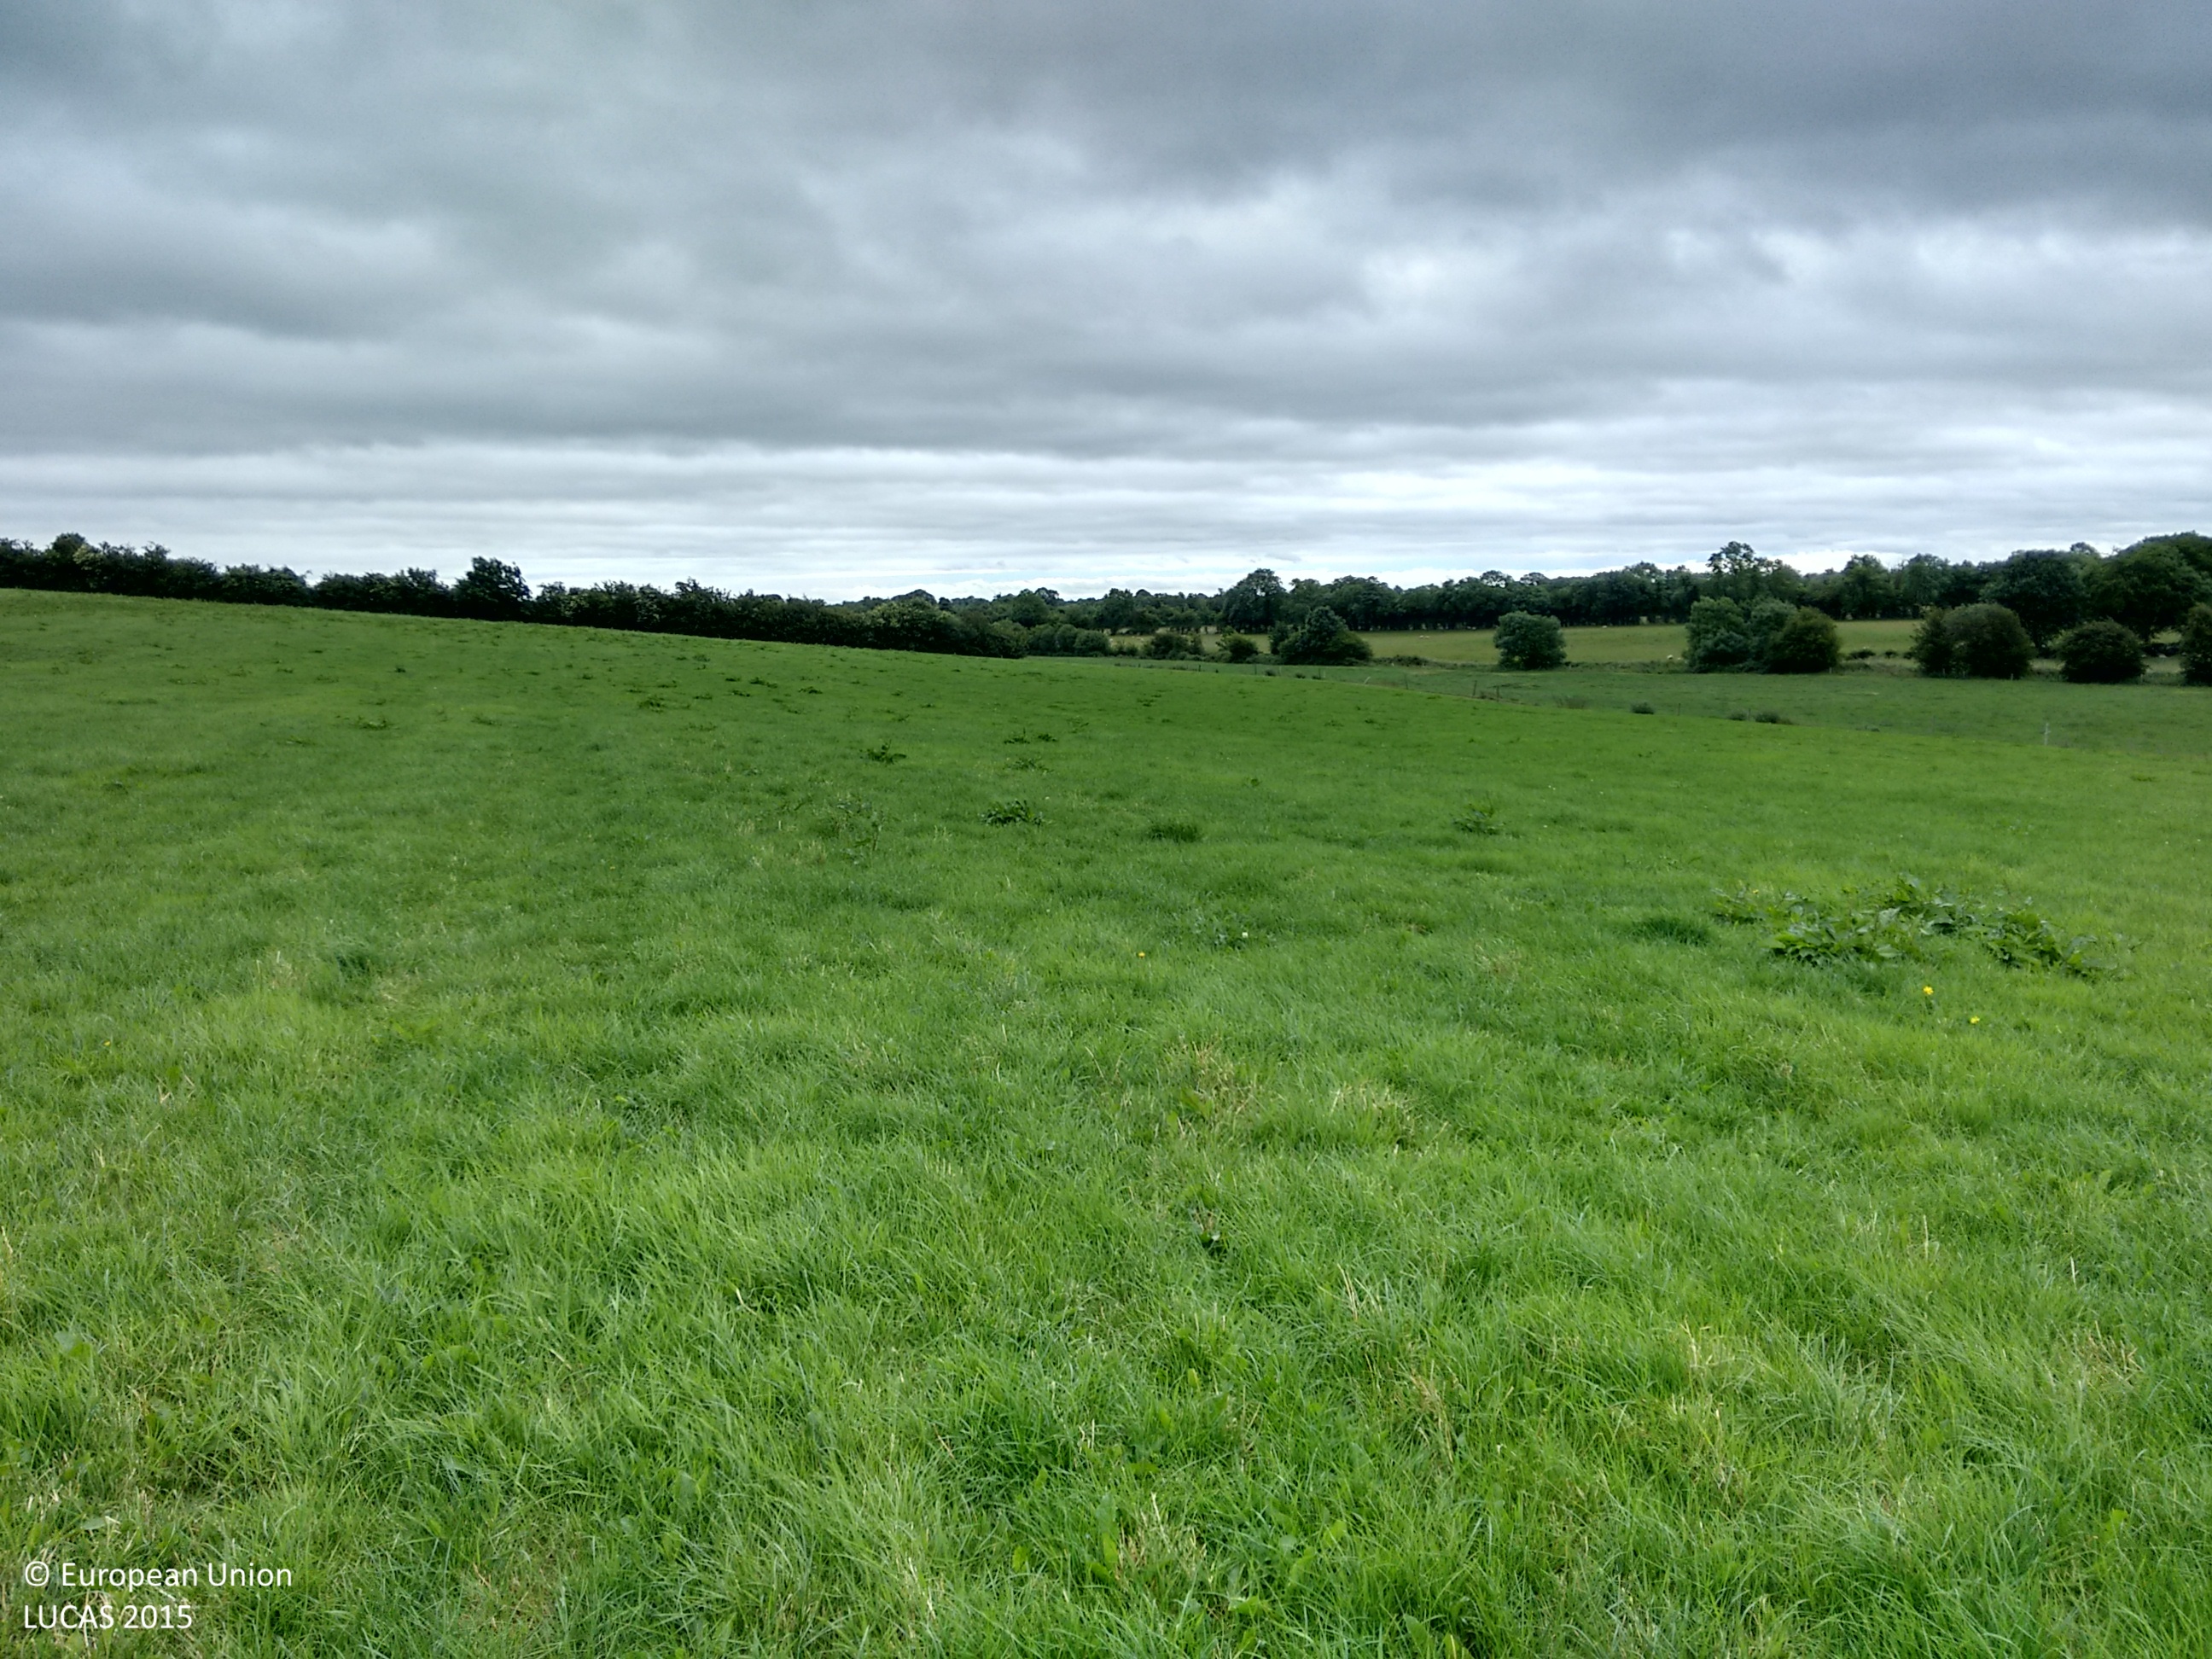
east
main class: Grassland
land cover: Grassland without tree/shrub cover
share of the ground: > 75 %
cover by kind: herbaceous plants 100 %
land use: Agriculture (excluding fallow land and kitchen gardens)
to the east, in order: Grassland without tree/shrub cover; Fences; Tracks; Fences; Grassland without tree/shrub cover; Fences; Ditches and canals; Fences; Grassland without tree/shrub cover
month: July
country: IE
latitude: 53.5138
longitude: -6.9861
